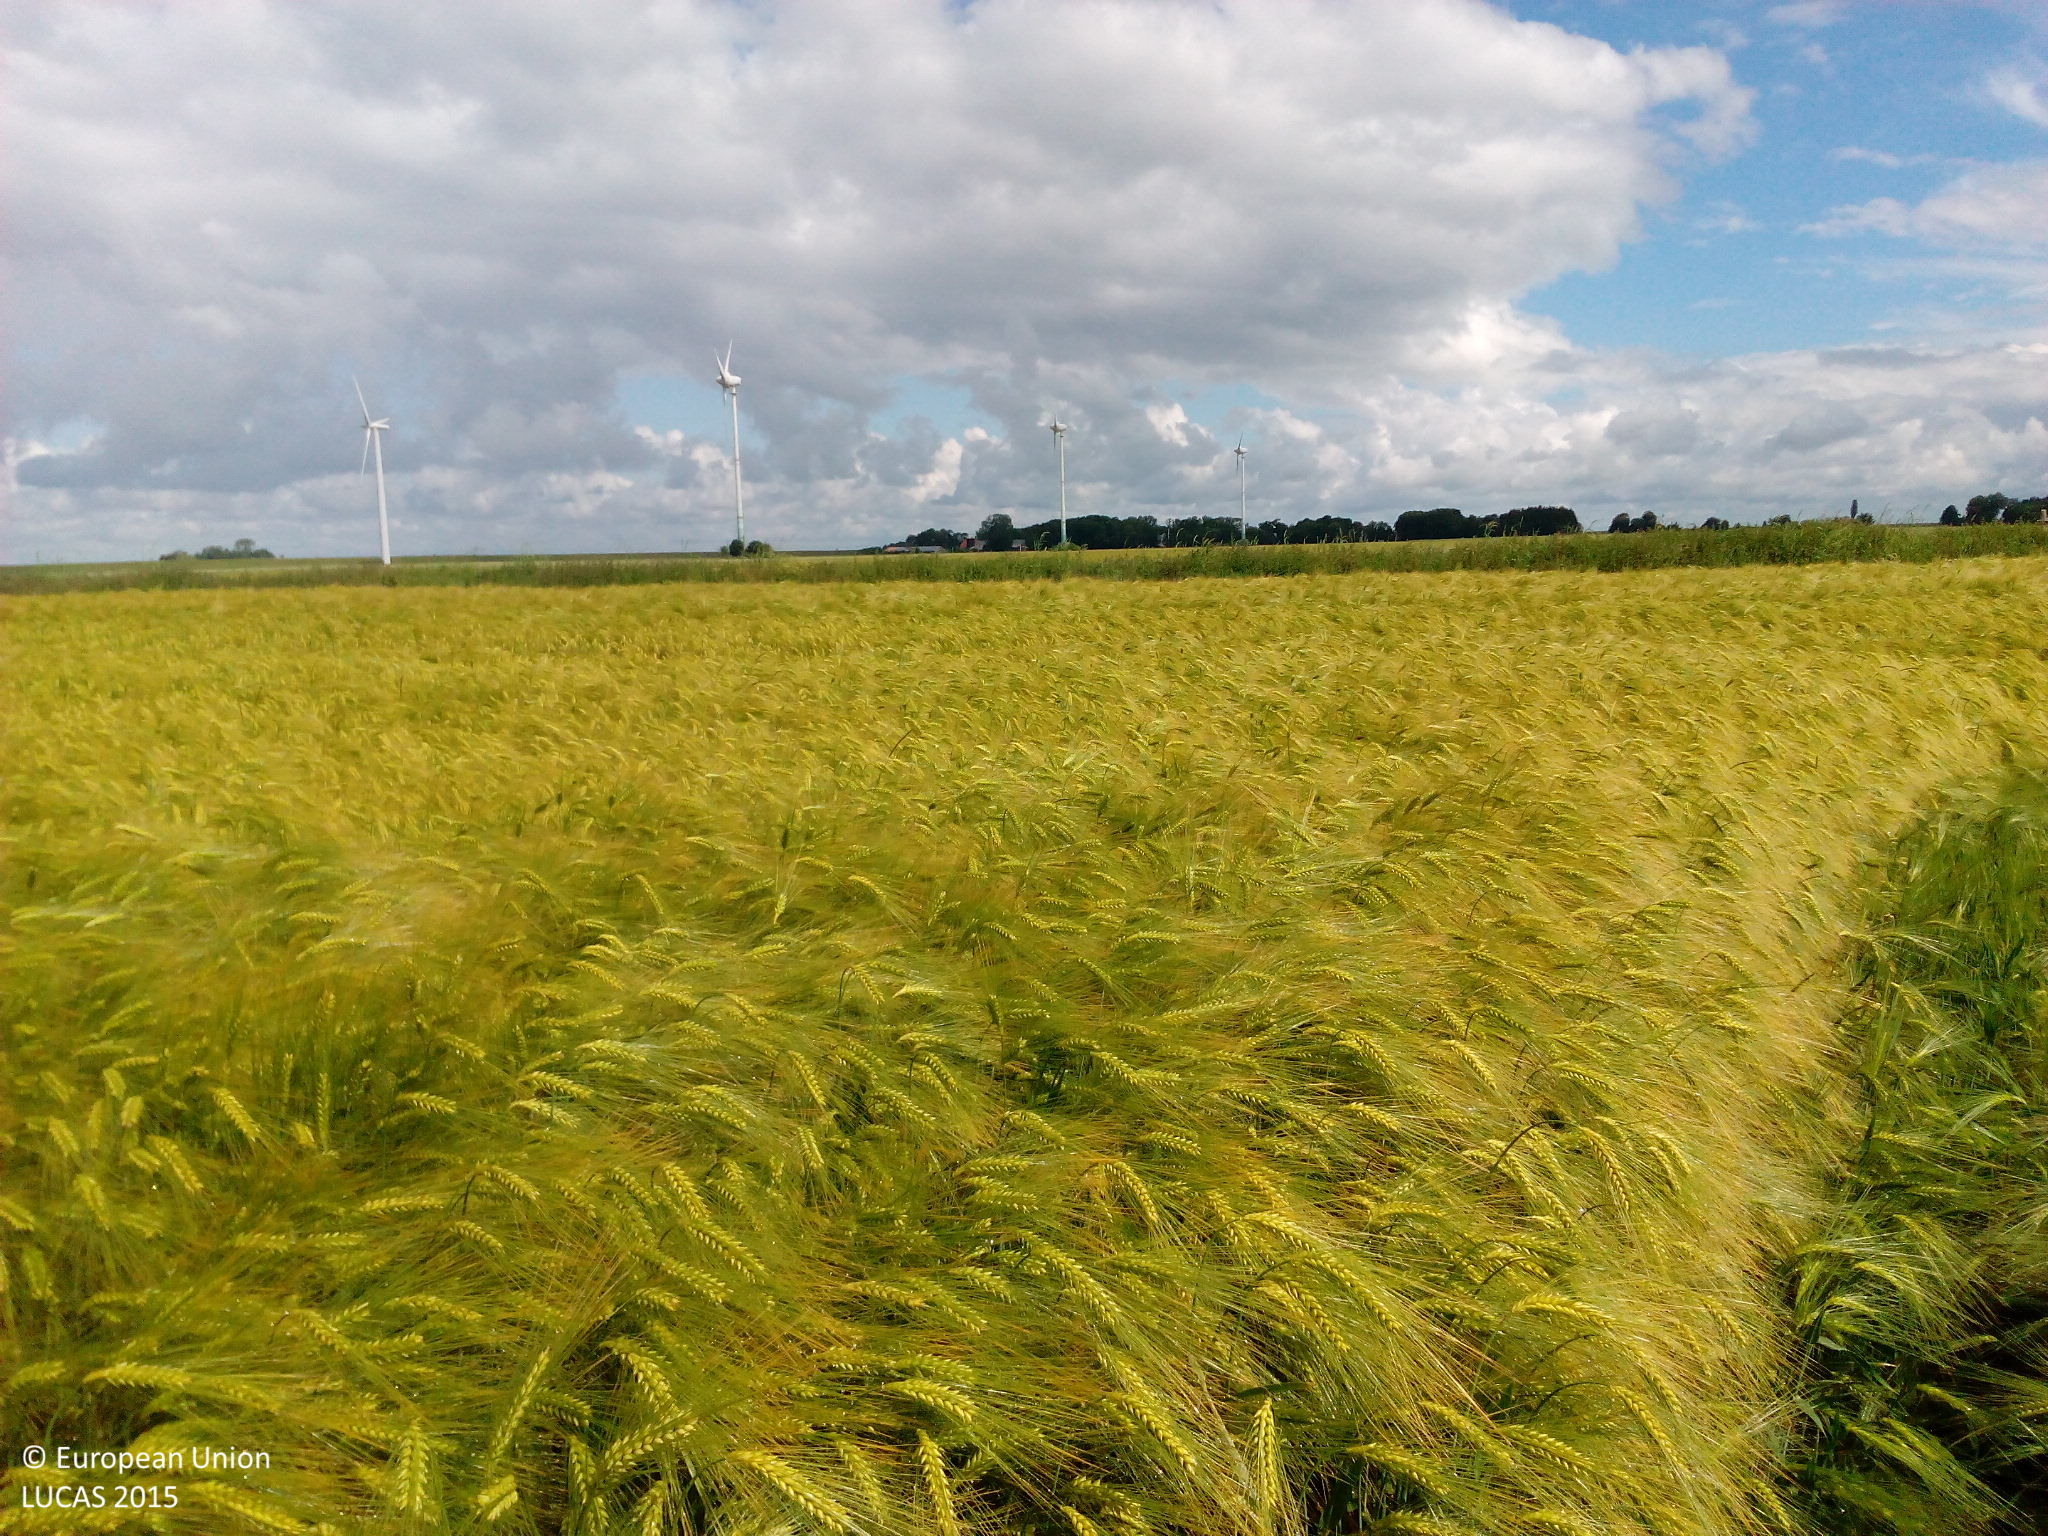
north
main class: Cropland
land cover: Barley
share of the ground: > 75 %
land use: Agriculture (excluding fallow land and kitchen gardens)
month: June
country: DE
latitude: 53.8118
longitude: 9.0741
